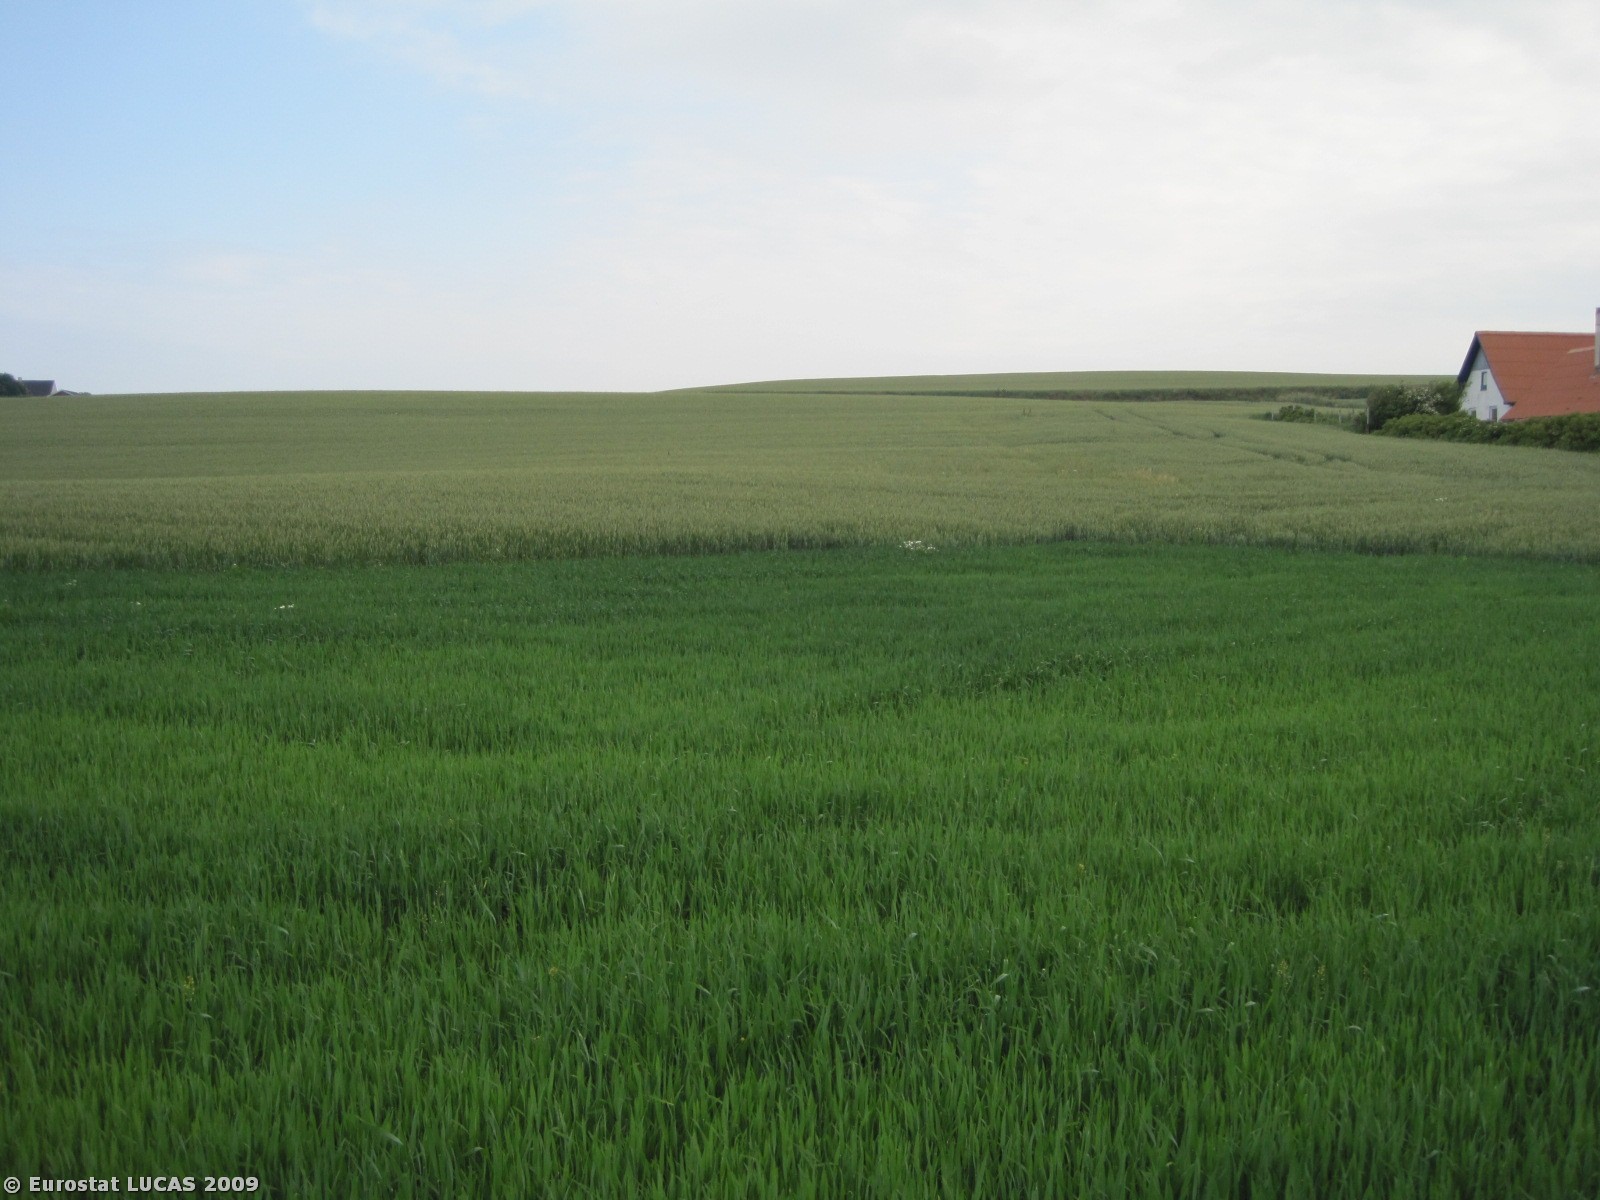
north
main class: Cropland
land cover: Common wheat
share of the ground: > 75 %
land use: Agriculture (excluding fallow land and kitchen gardens)
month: June
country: DK
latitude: 56.5549
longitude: 8.3589
